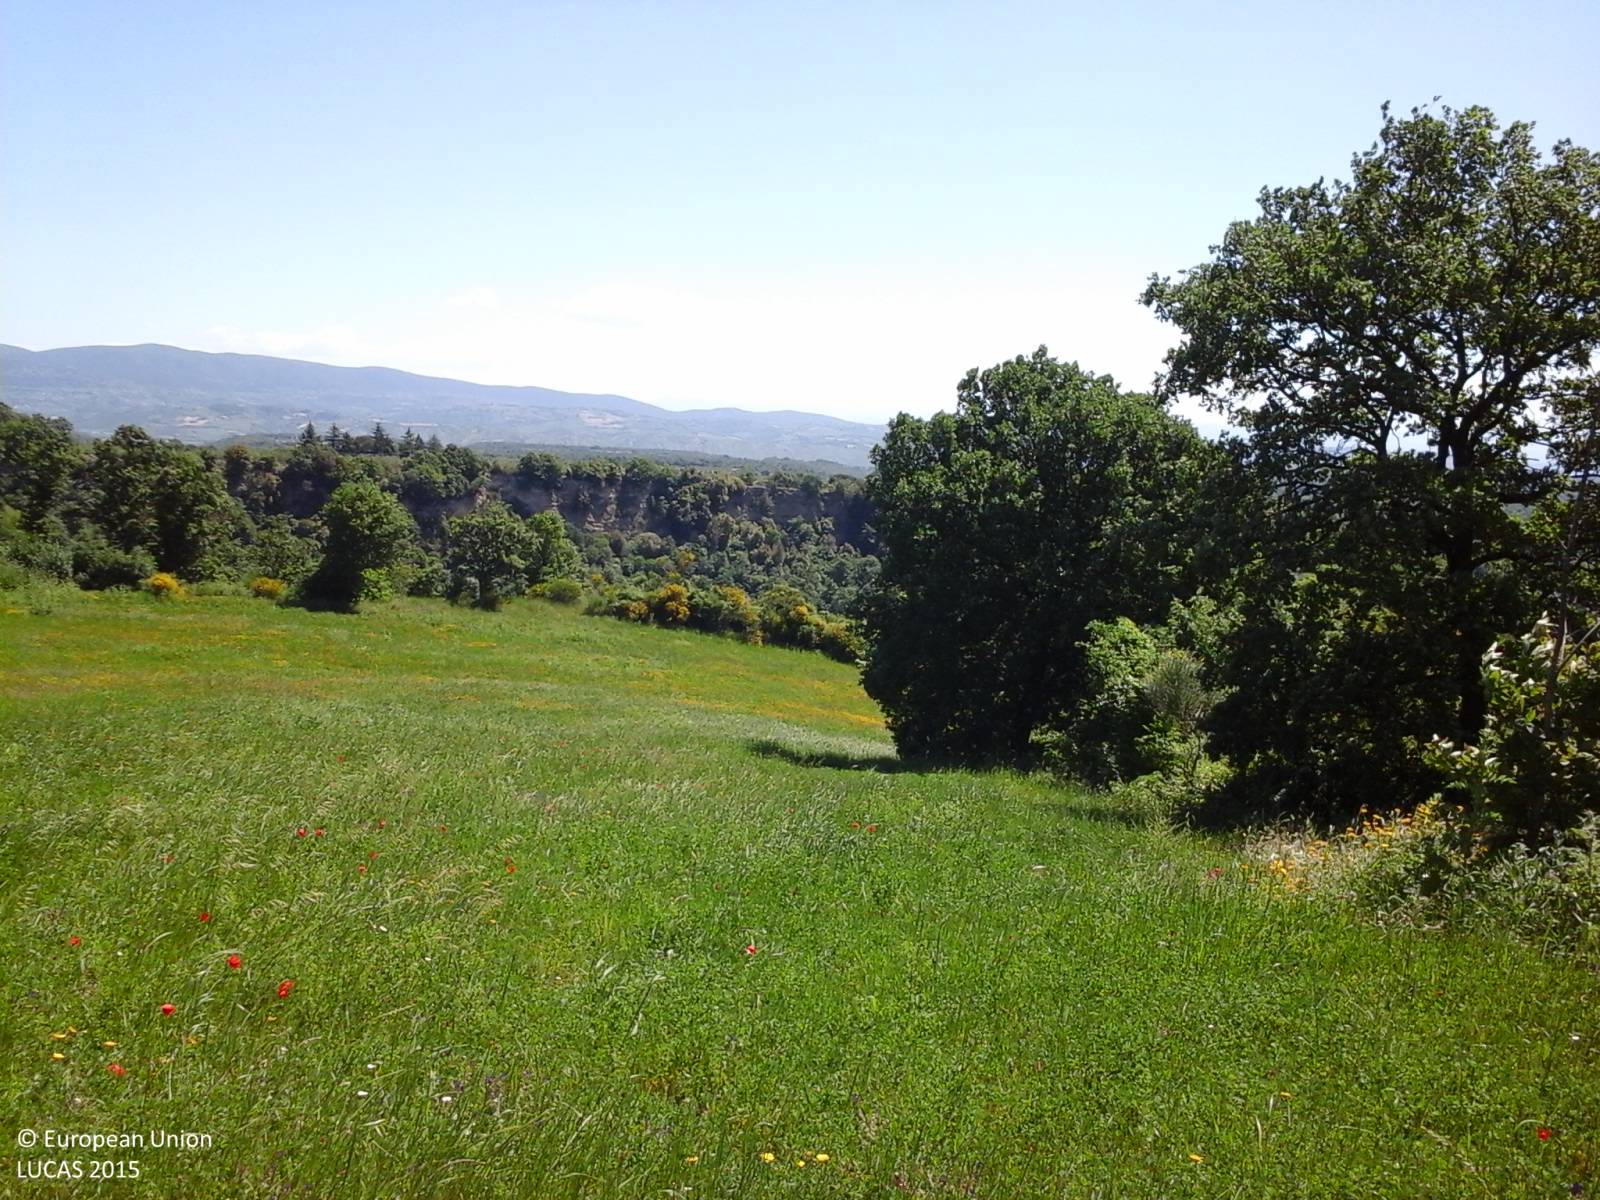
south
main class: Cropland
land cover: Lucerne
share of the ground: > 75 %
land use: Agriculture (excluding fallow land and kitchen gardens)
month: May
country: IT
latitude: 42.5585
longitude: 12.1730
